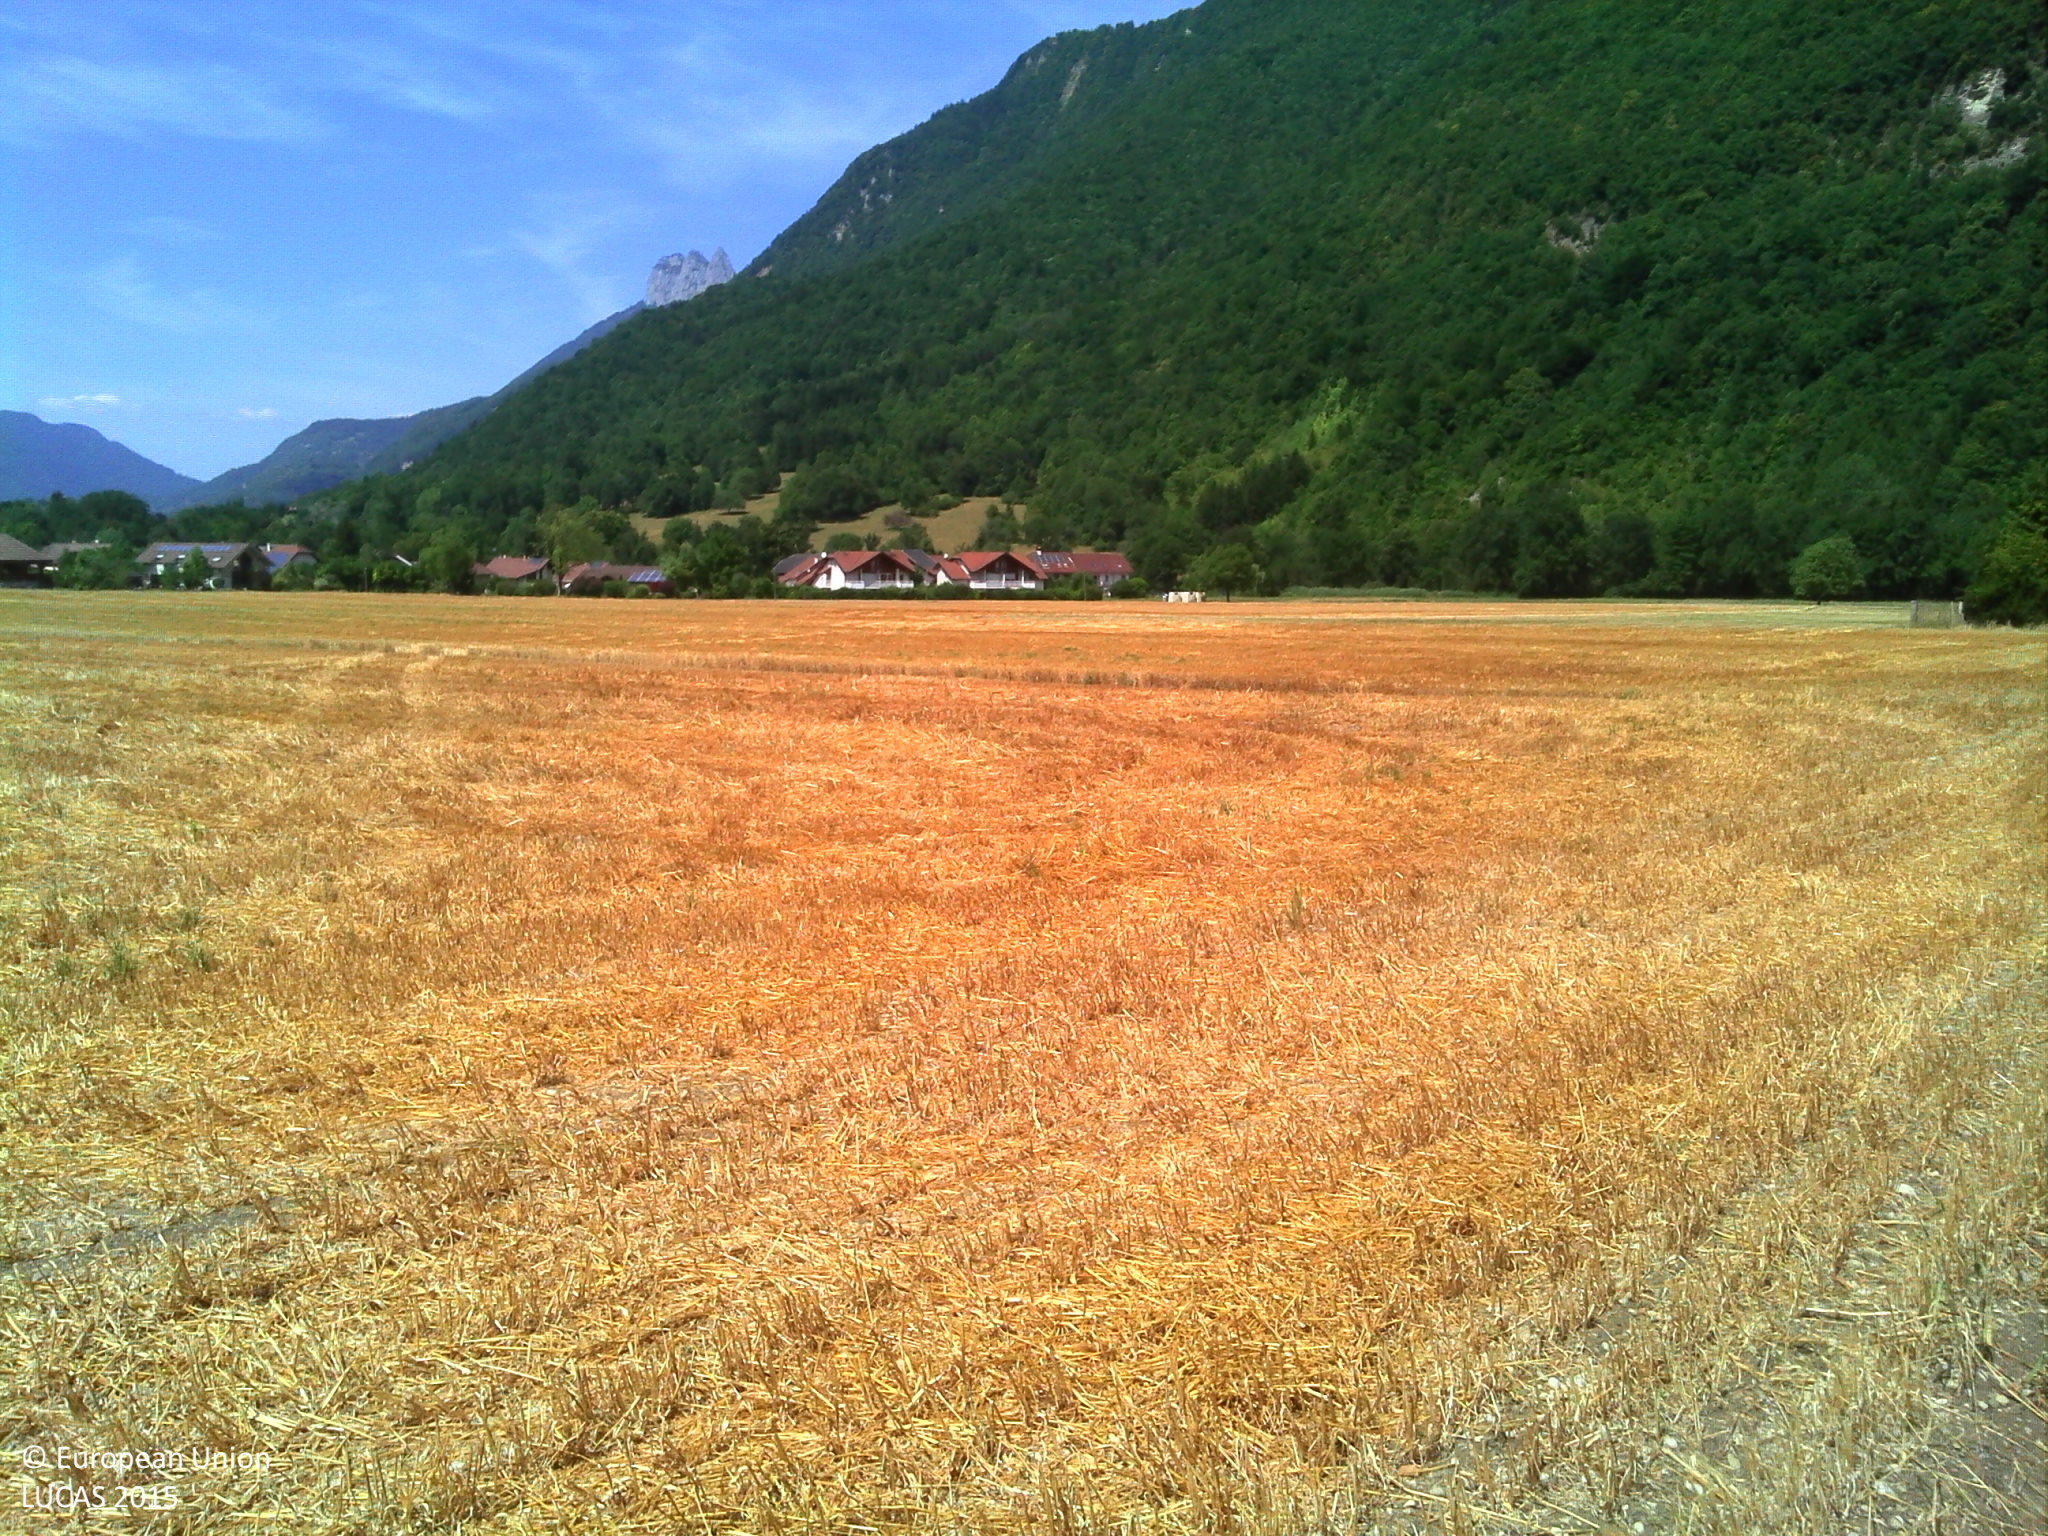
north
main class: Cropland
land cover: Rye
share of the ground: < 10 %
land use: Agriculture (excluding fallow land and kitchen gardens)
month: July
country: FR
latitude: 45.7801
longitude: 6.2357
